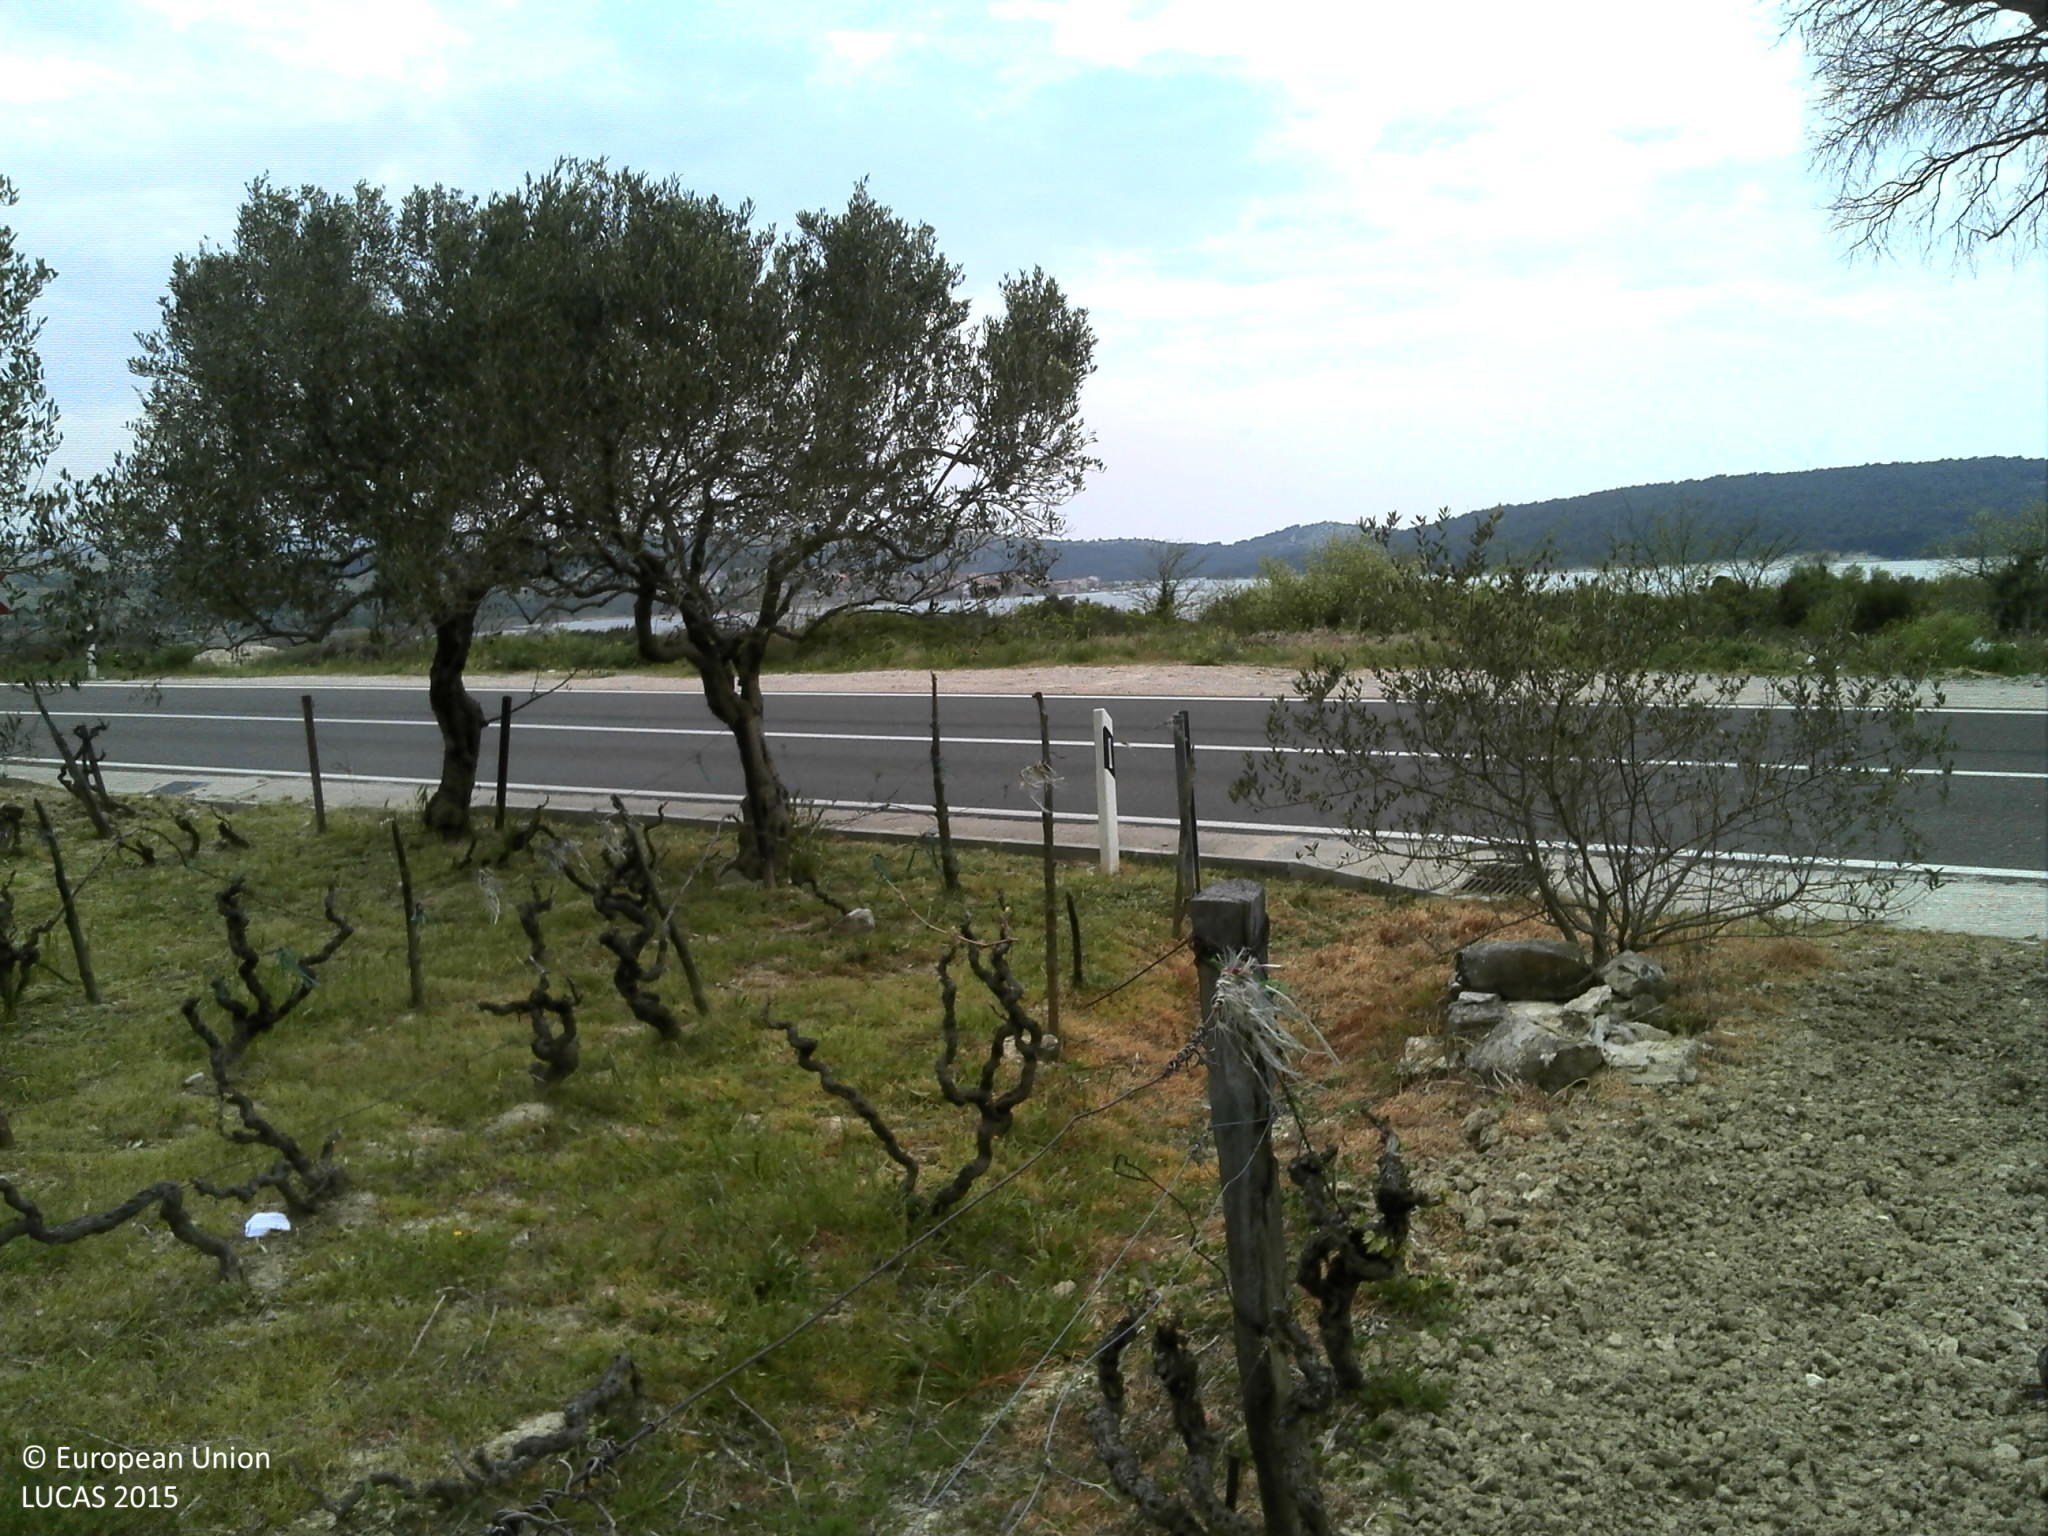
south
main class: Cropland
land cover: Vineyards
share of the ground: > 75 %
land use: Agriculture (excluding fallow land and kitchen gardens)
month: April
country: HR
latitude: 43.6910
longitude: 15.9586
